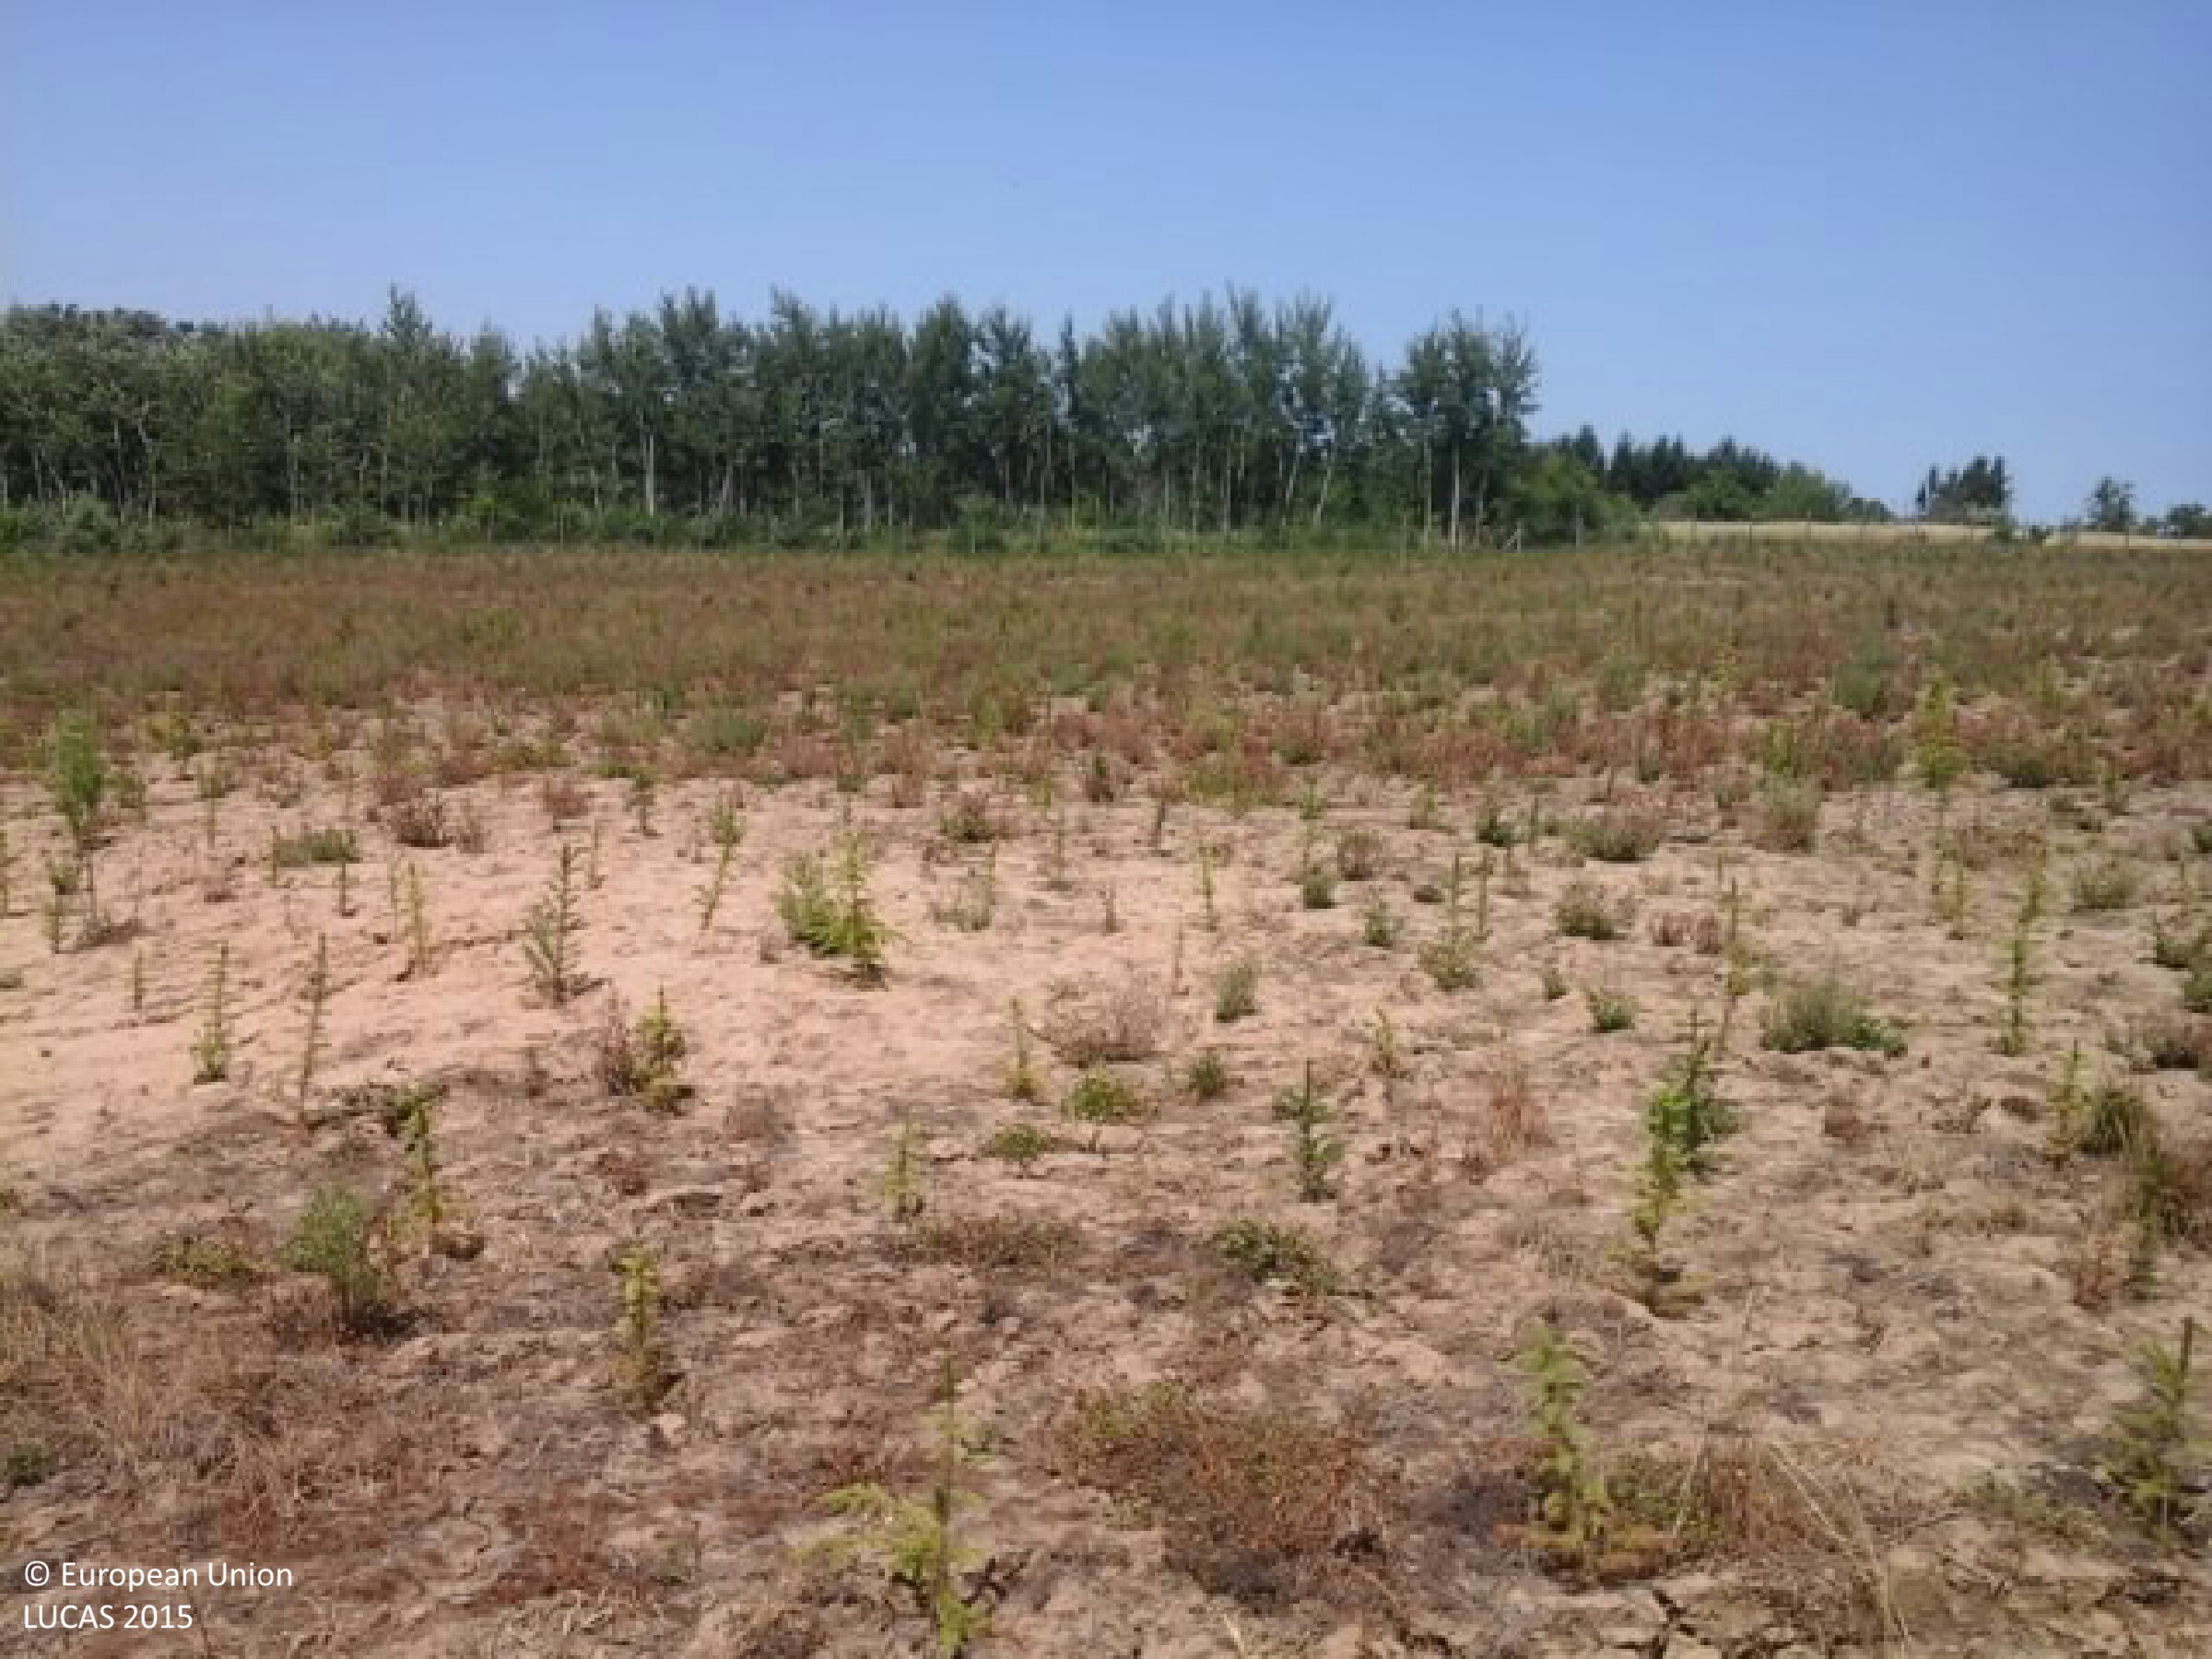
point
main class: Cropland
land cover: Nurseries
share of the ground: 25 - 50 %
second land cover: Spontaneously vegetated surfaces
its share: 50 - 75 %
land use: Forestry
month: July
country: HU
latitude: 46.2795
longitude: 17.0754
